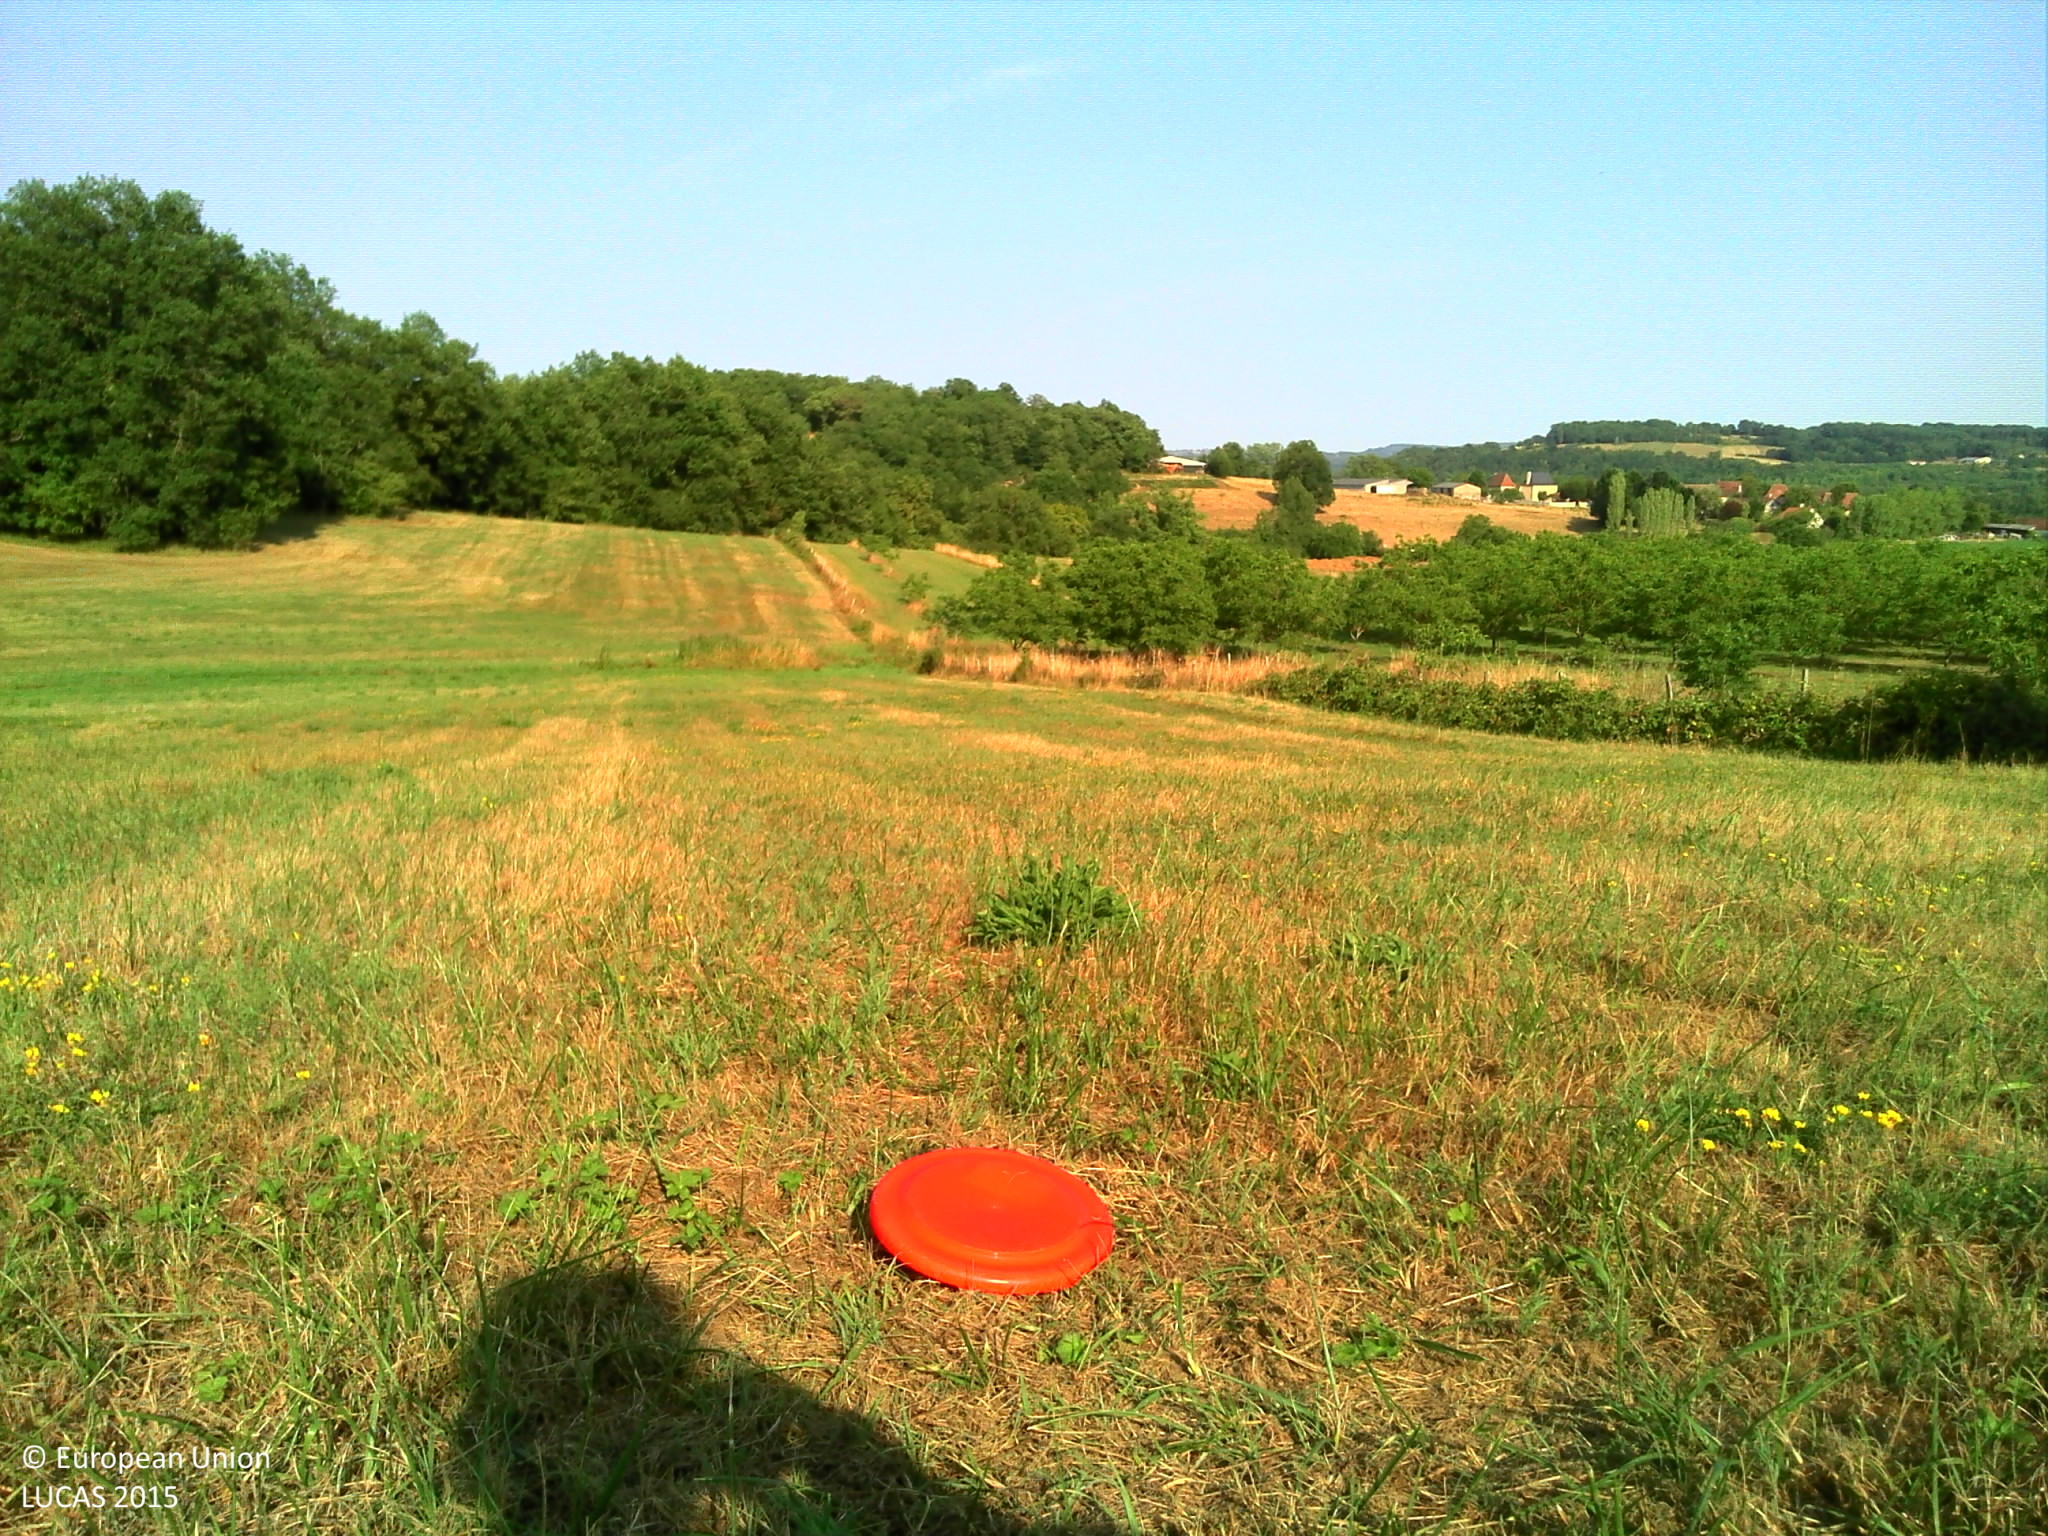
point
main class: Grassland
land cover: Grassland without tree/shrub cover
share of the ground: > 75 %
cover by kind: herbaceous plants 100 %
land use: Agriculture (excluding fallow land and kitchen gardens)
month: July
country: FR
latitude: 45.2893
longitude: 1.0797
